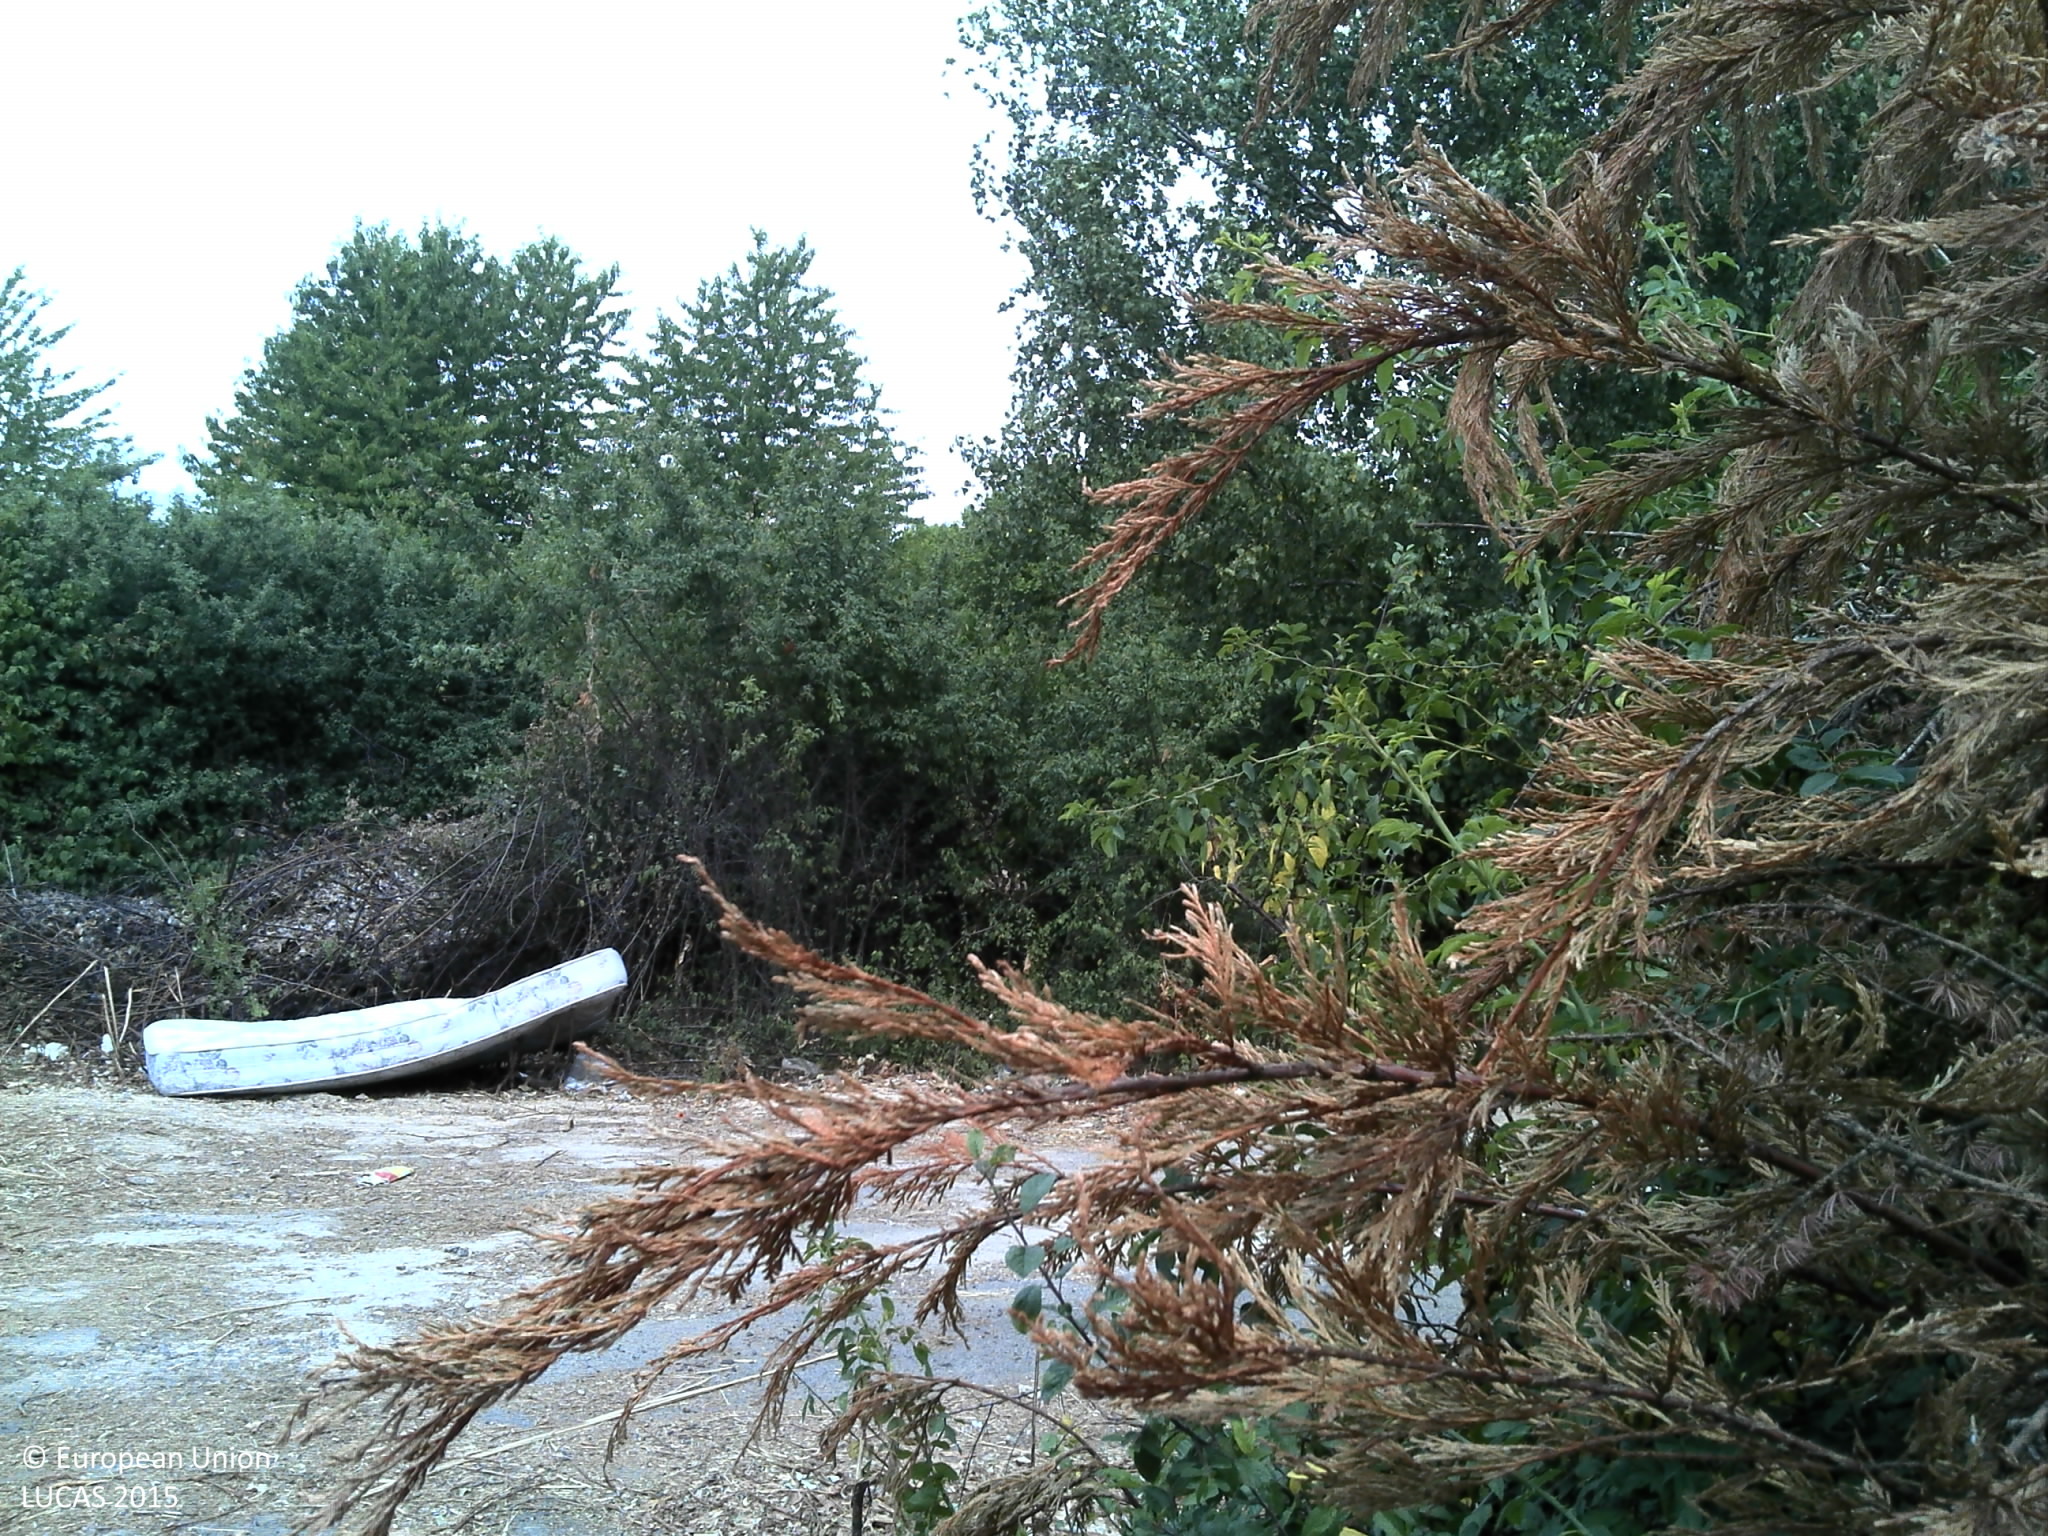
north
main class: Woodland
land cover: Broadleaved woodland
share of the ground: > 75 %
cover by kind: shrubs 80 %, broadleaved forest trees 20 %
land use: Semi-natural and natural areas not in use
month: July
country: FR
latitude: 48.6139
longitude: 2.4336
